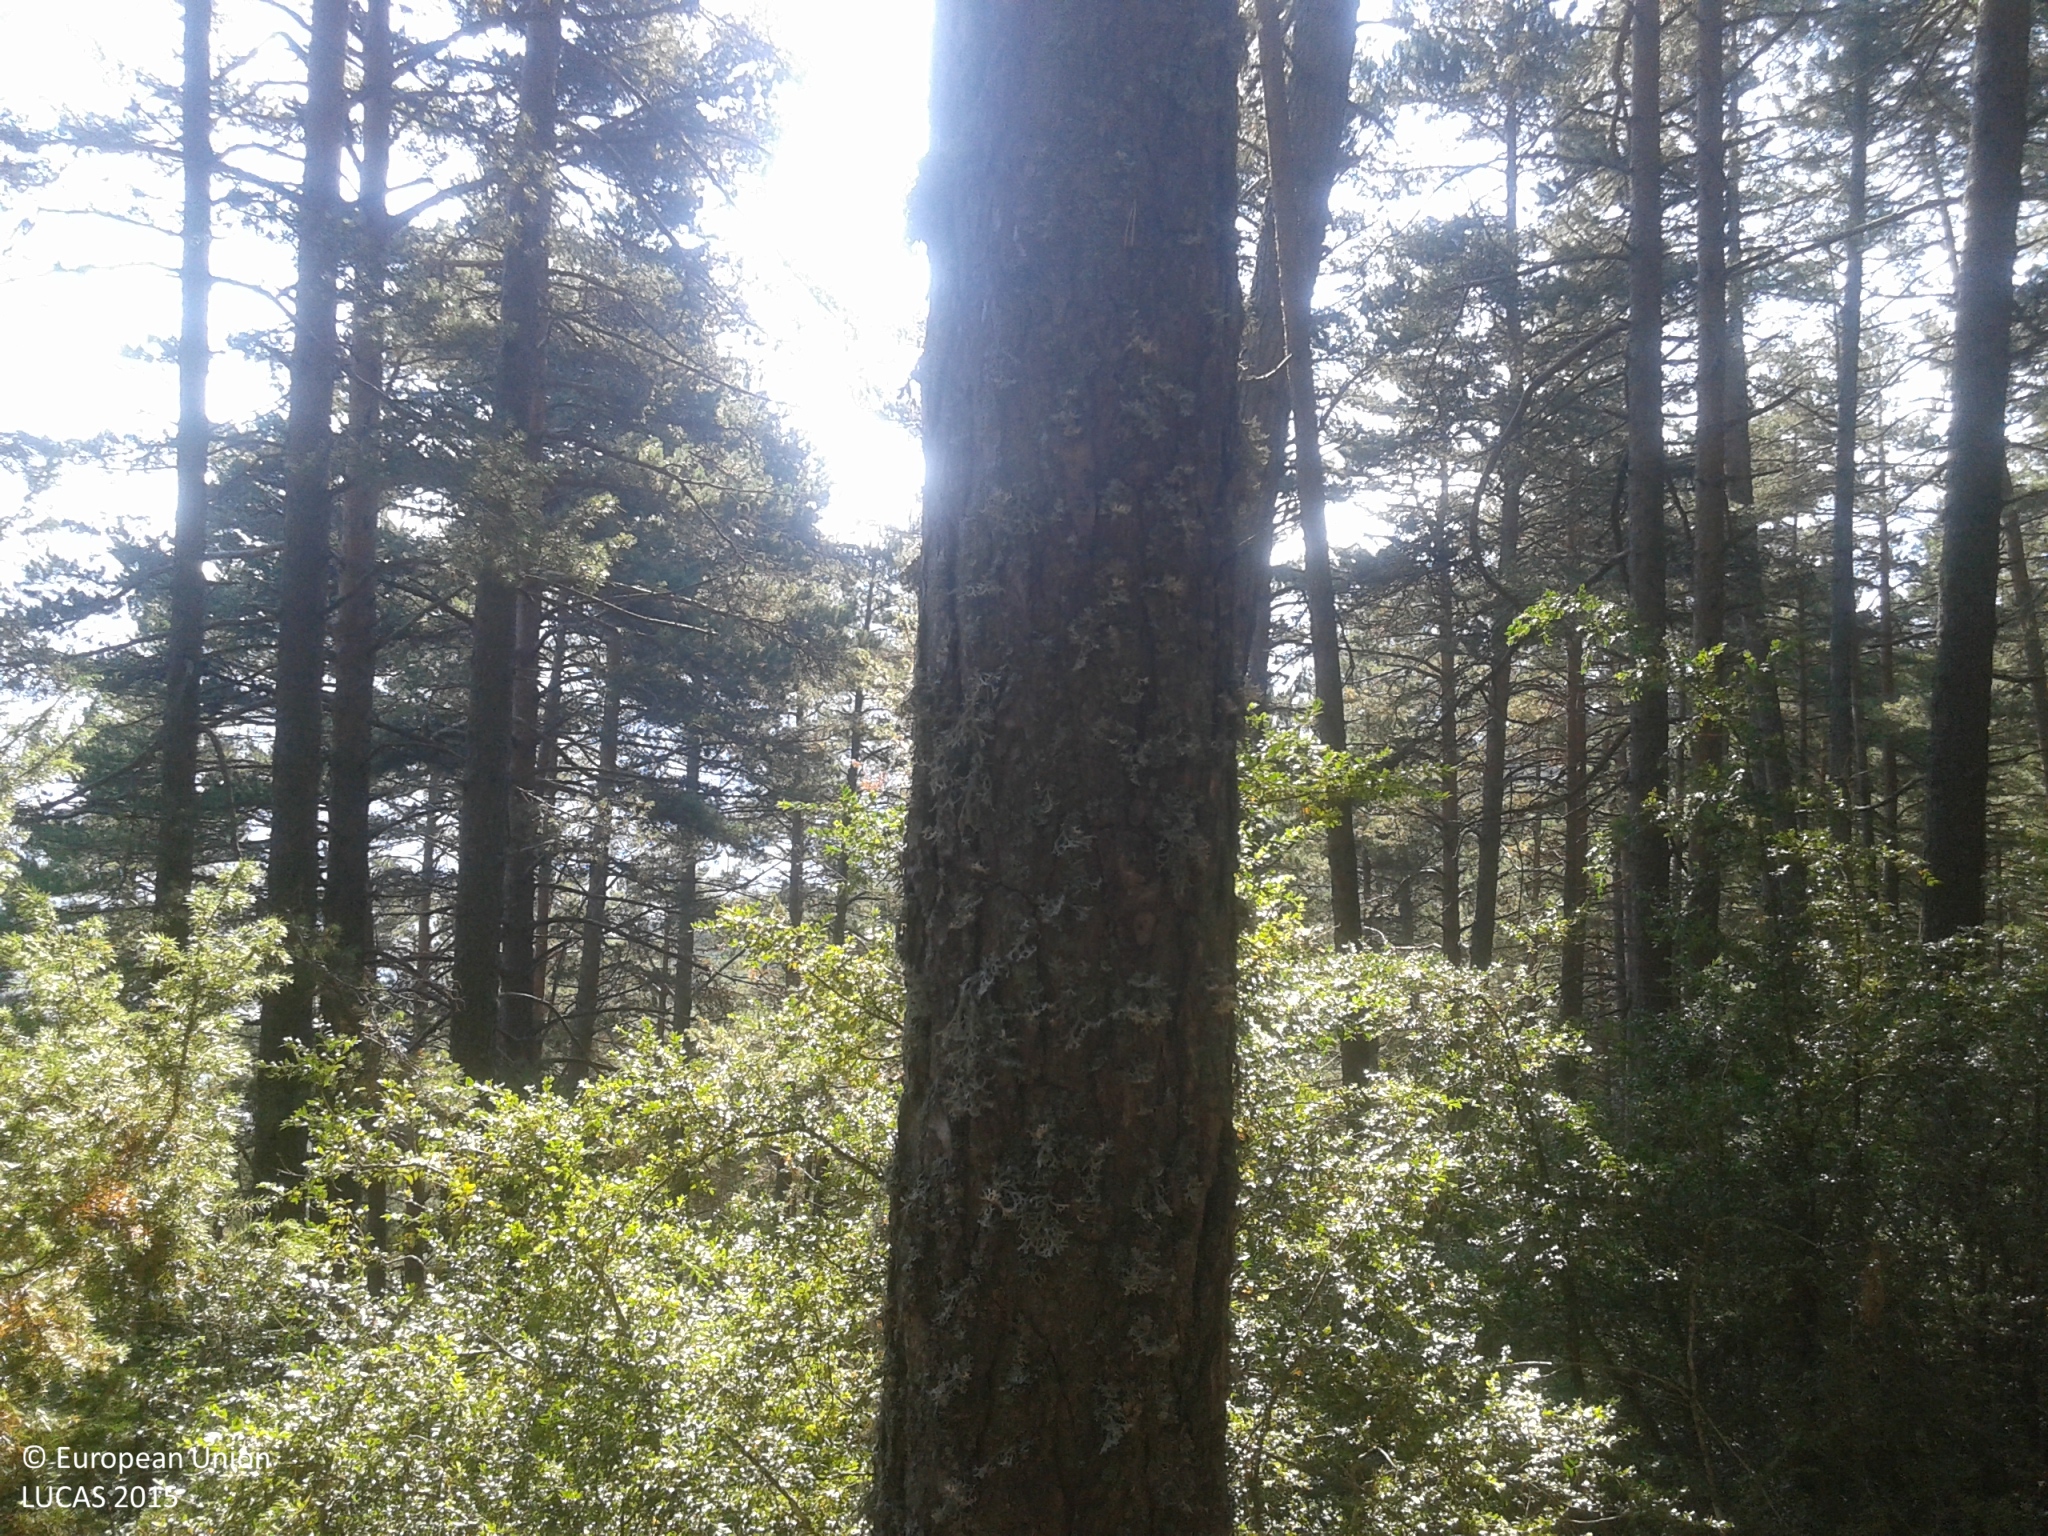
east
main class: Woodland
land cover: Pine dominated coniferous woodland
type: alpine coniferous forest
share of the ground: > 75 %
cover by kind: coniferous forest trees 95 %, shrubs 5 %
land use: Forestry
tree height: > 5 m
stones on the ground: 25 - 50 %
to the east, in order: Pine dominated coniferous woodland
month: July
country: ES
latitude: 42.2271
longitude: 1.5421
